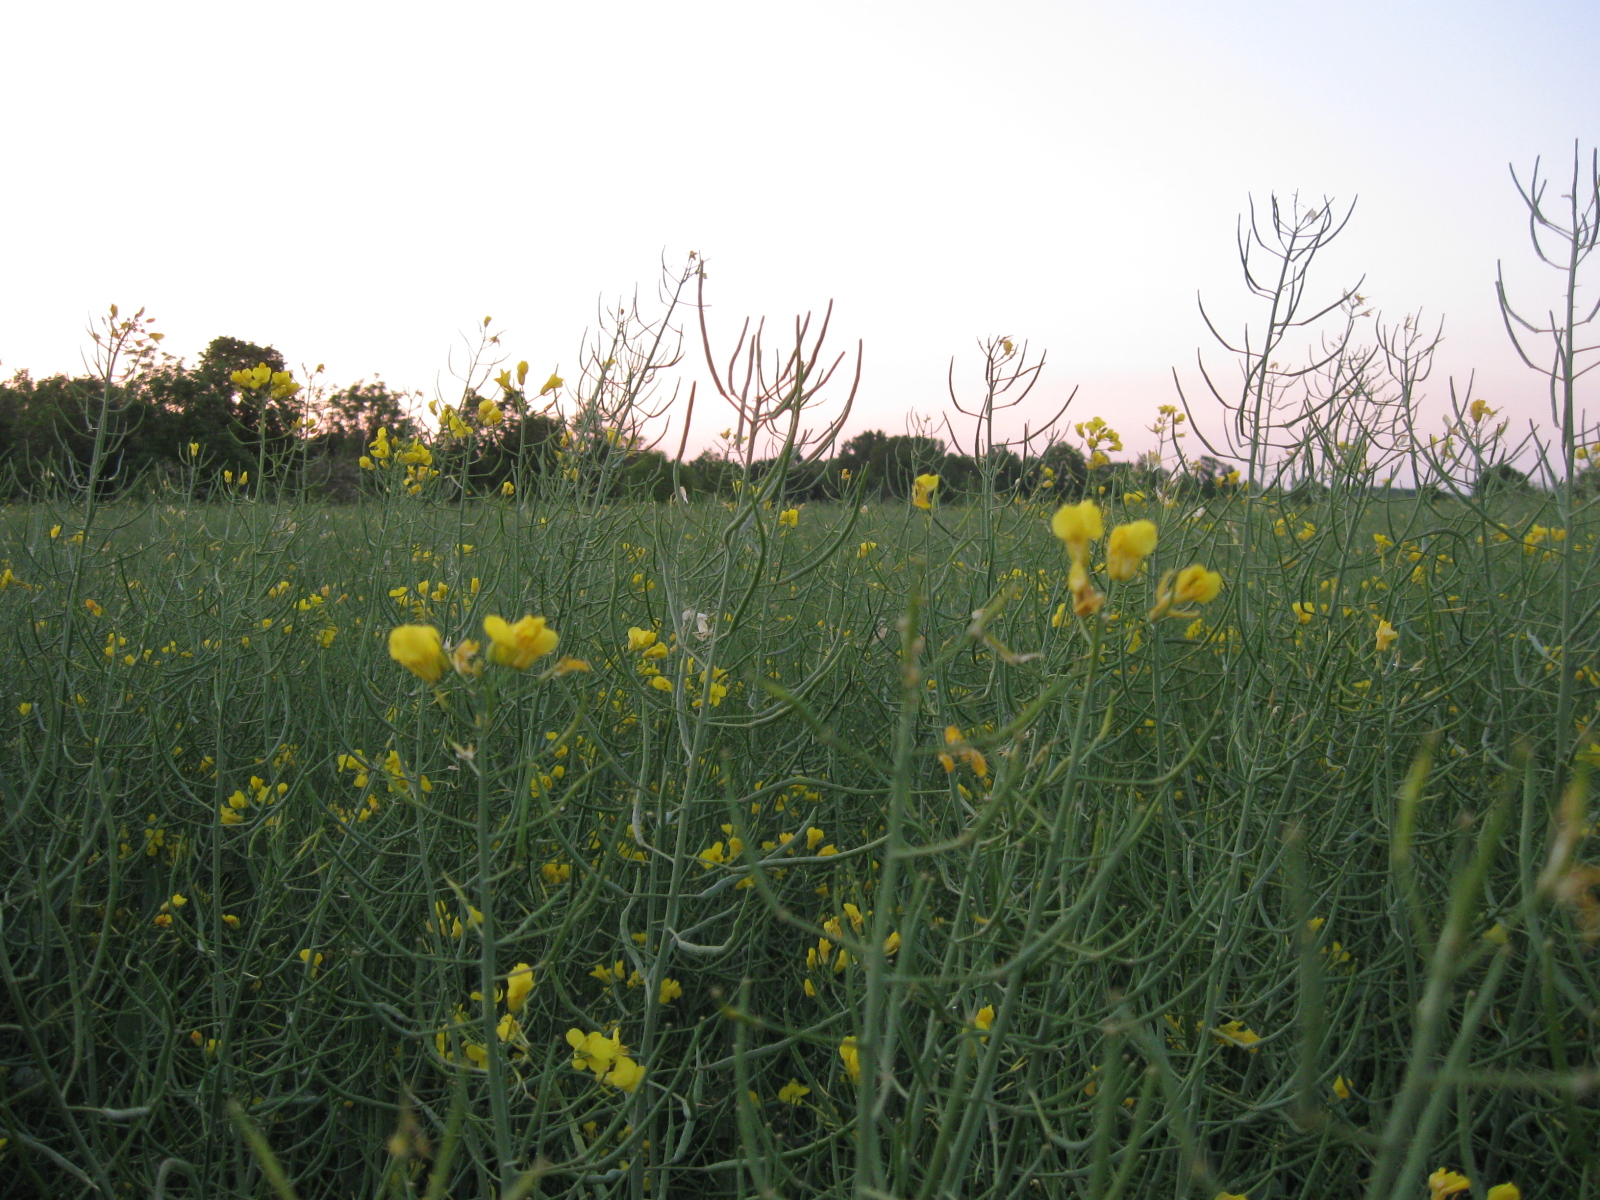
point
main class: Cropland
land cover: Rape and turnip rape
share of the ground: > 75 %
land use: Agriculture (excluding fallow land and kitchen gardens)
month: June
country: LT
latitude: 54.4827
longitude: 23.8413
